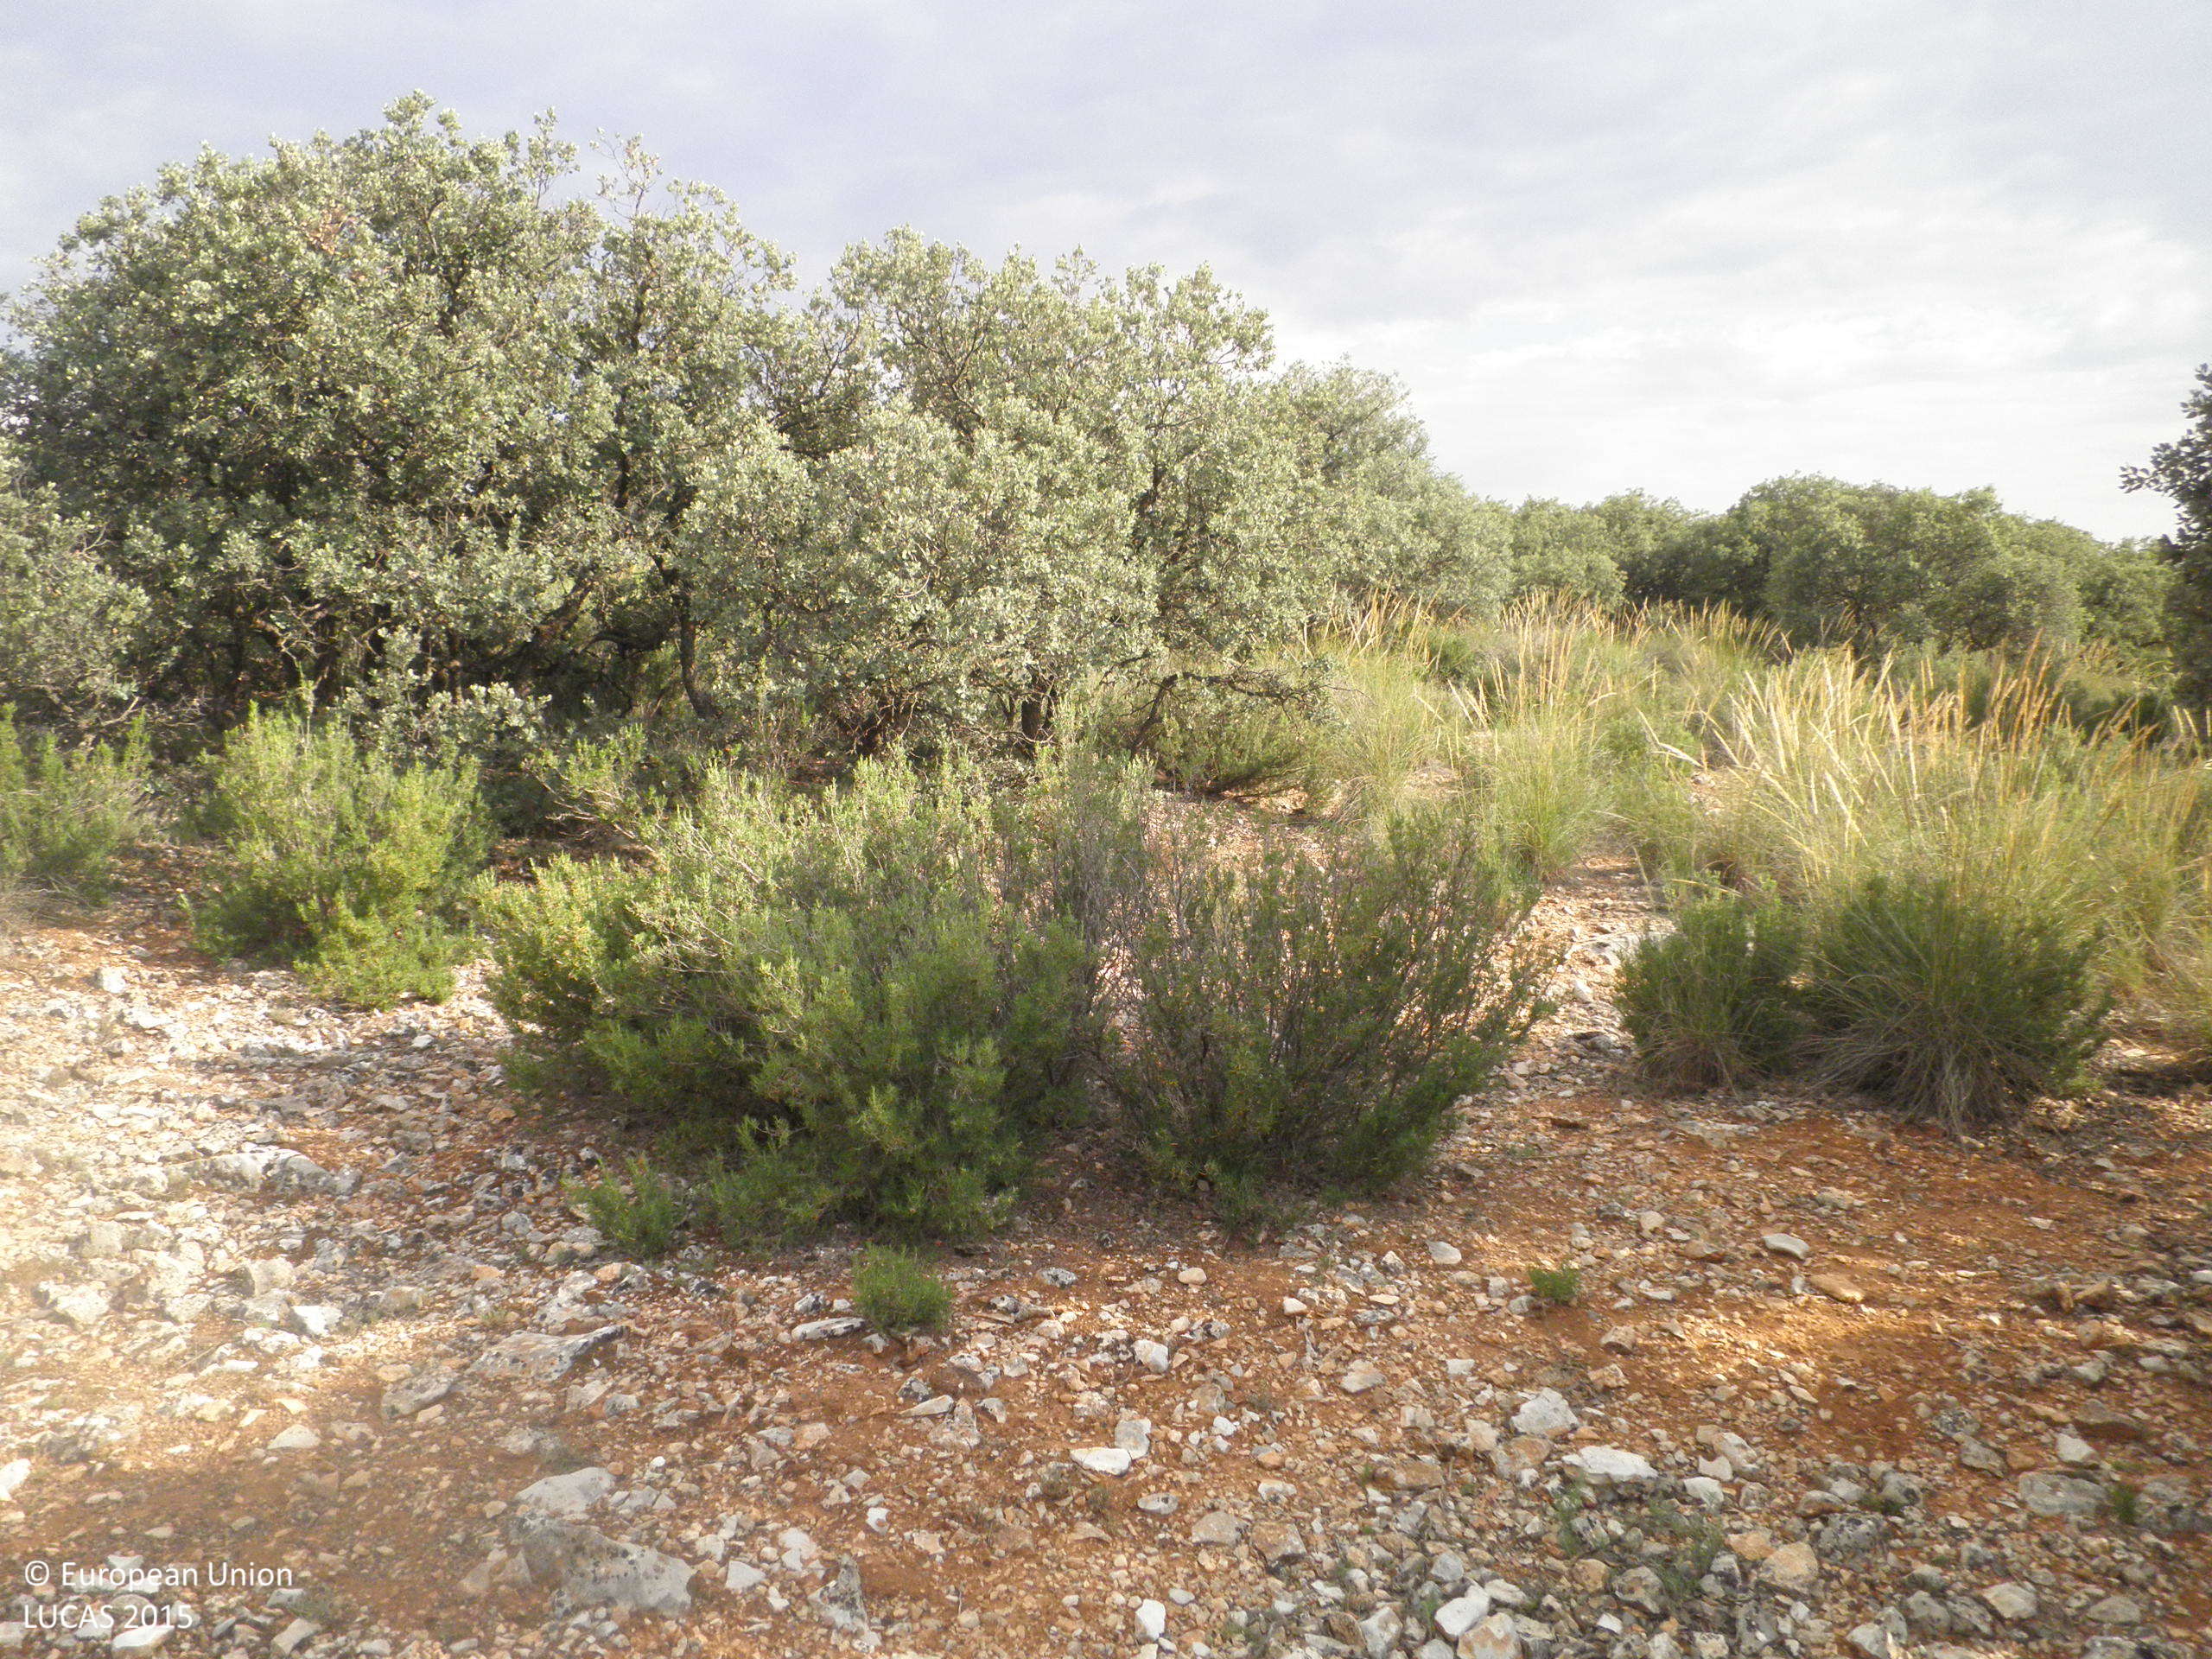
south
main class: Woodland
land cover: Broadleaved woodland
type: broadleaved evergreen forest
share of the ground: 25 - 50 %
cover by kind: shrubs 35 %, unconsolidated bare surface 30 %, broadleaved forest trees 25 %, consolidated bare surface 10 %
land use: Semi-natural and natural areas not in use
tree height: < 5 m
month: June
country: ES
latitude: 39.4553
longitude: -1.8483
